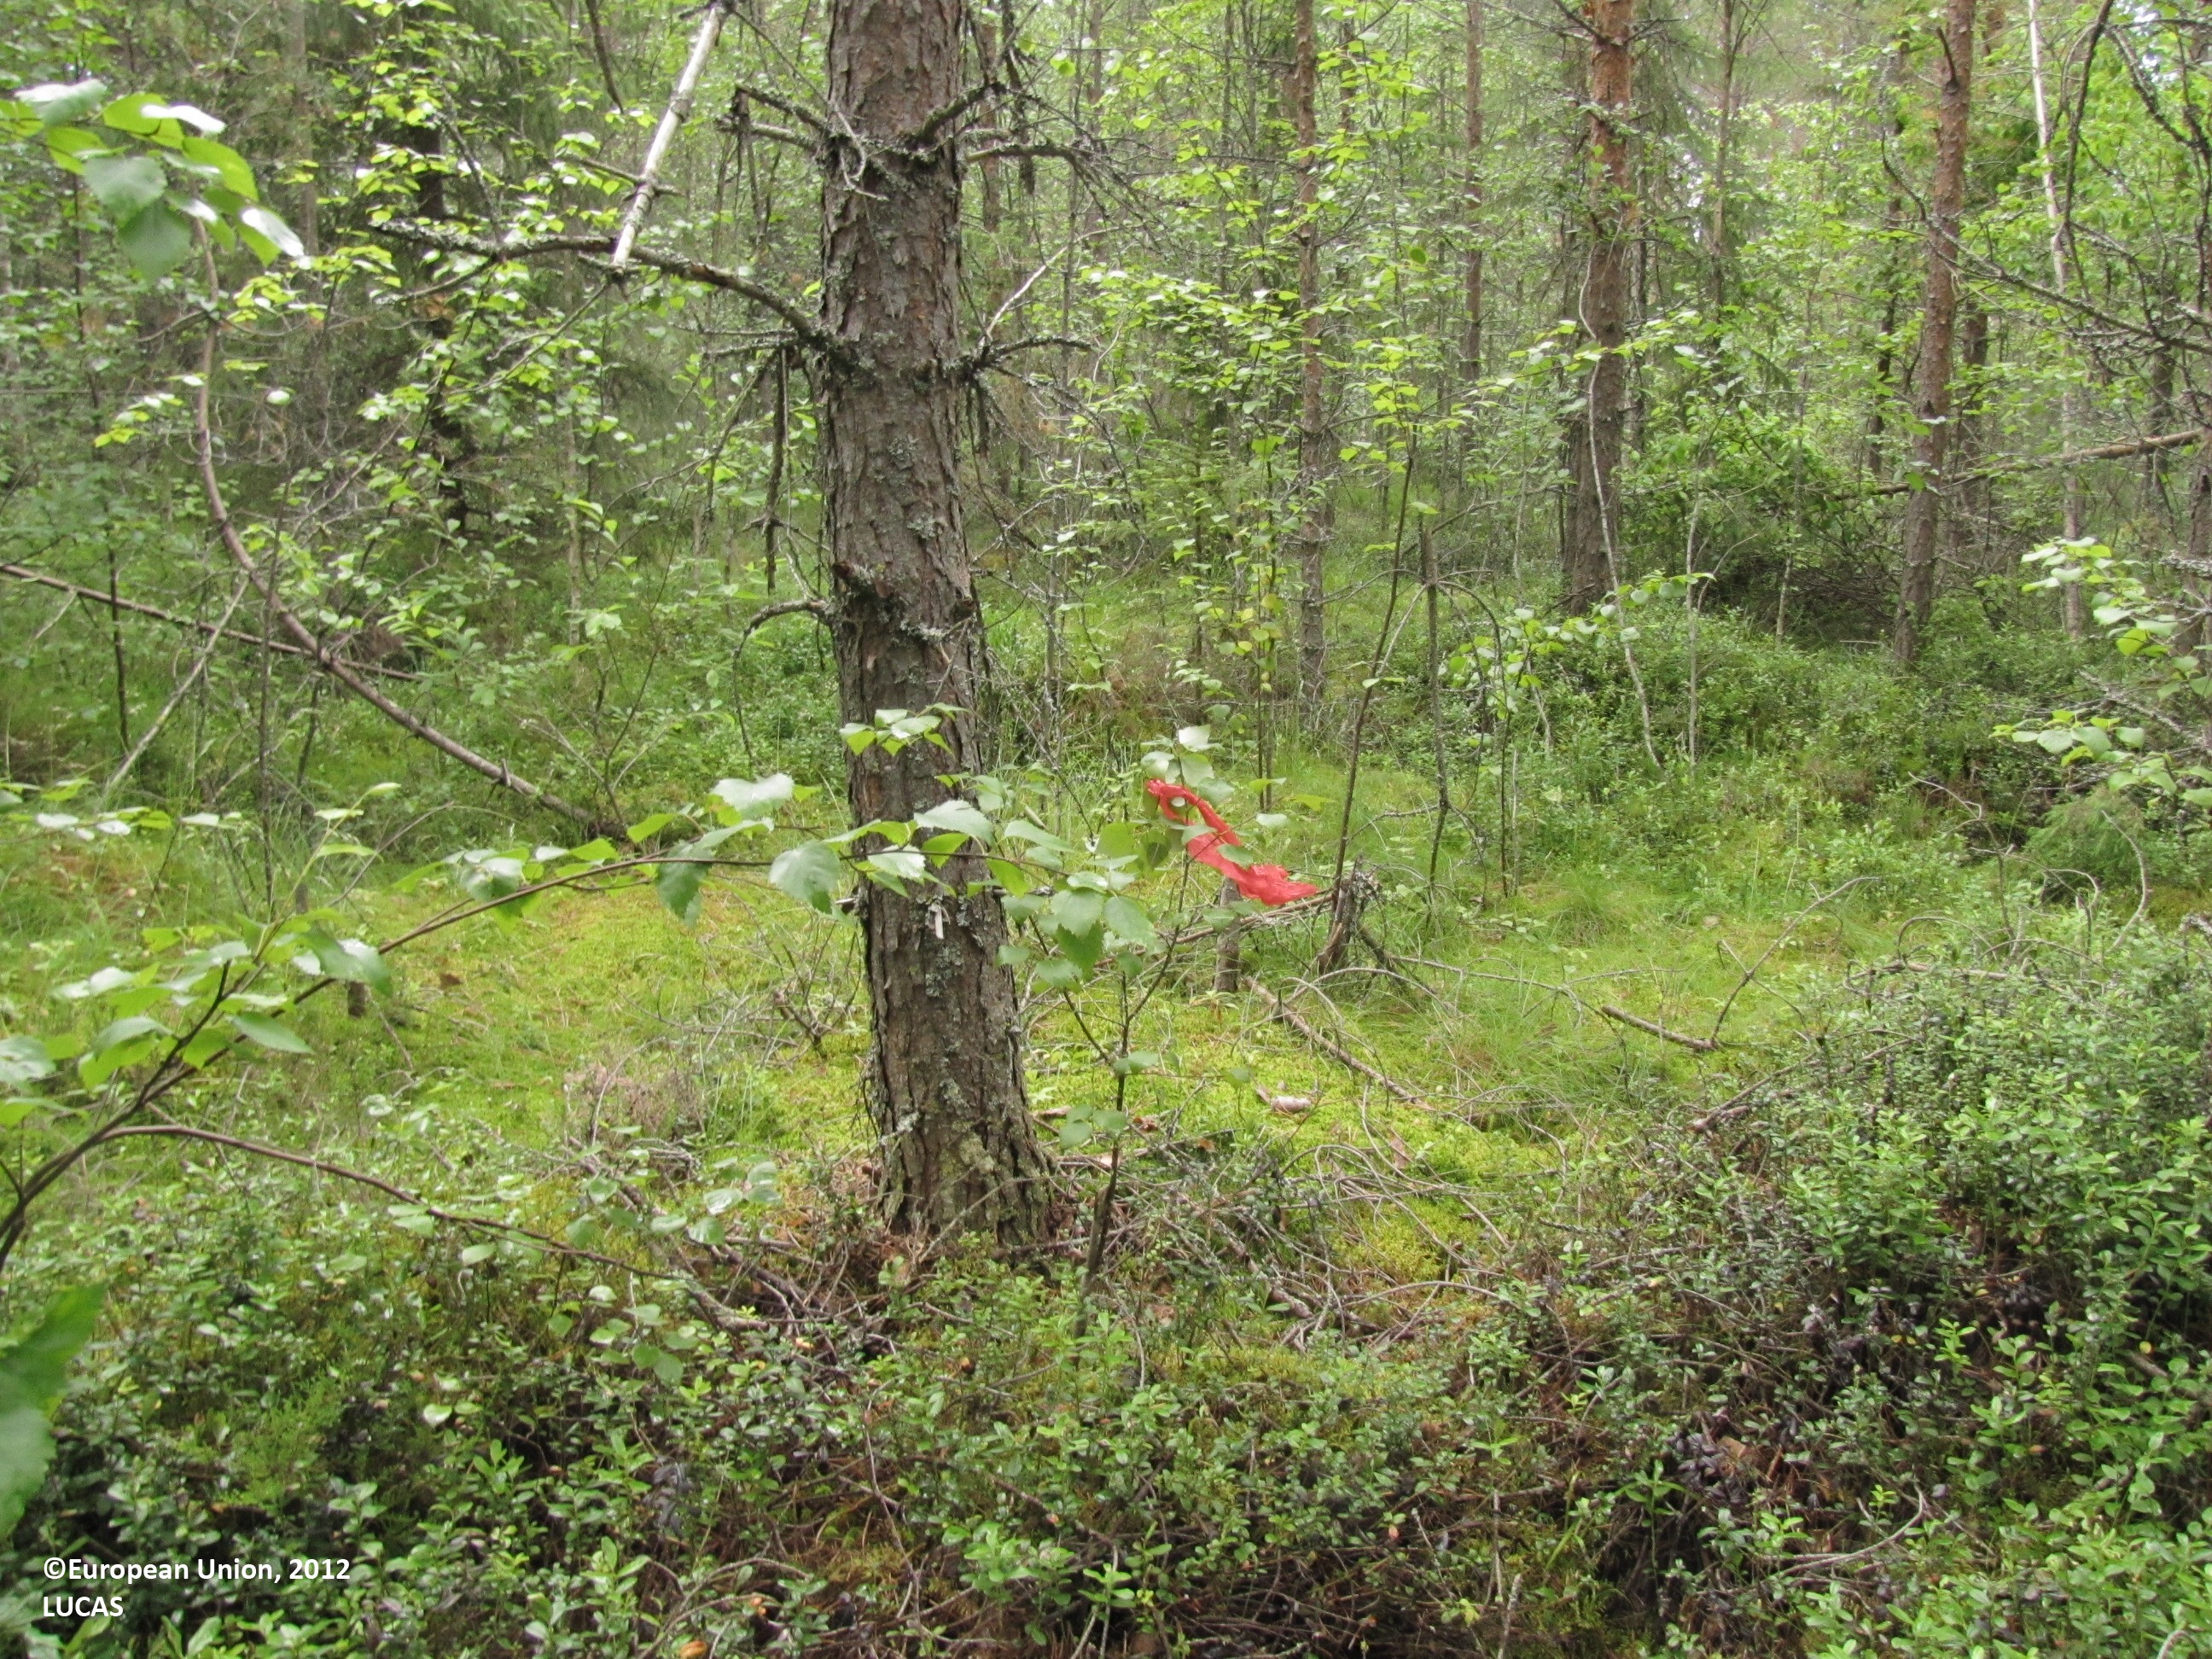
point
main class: Woodland
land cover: Pine dominated mixed woodland
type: boreal forest
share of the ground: > 75 %
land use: Forestry
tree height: > 5 m
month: July
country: FI
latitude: 62.5048
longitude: 24.0010
